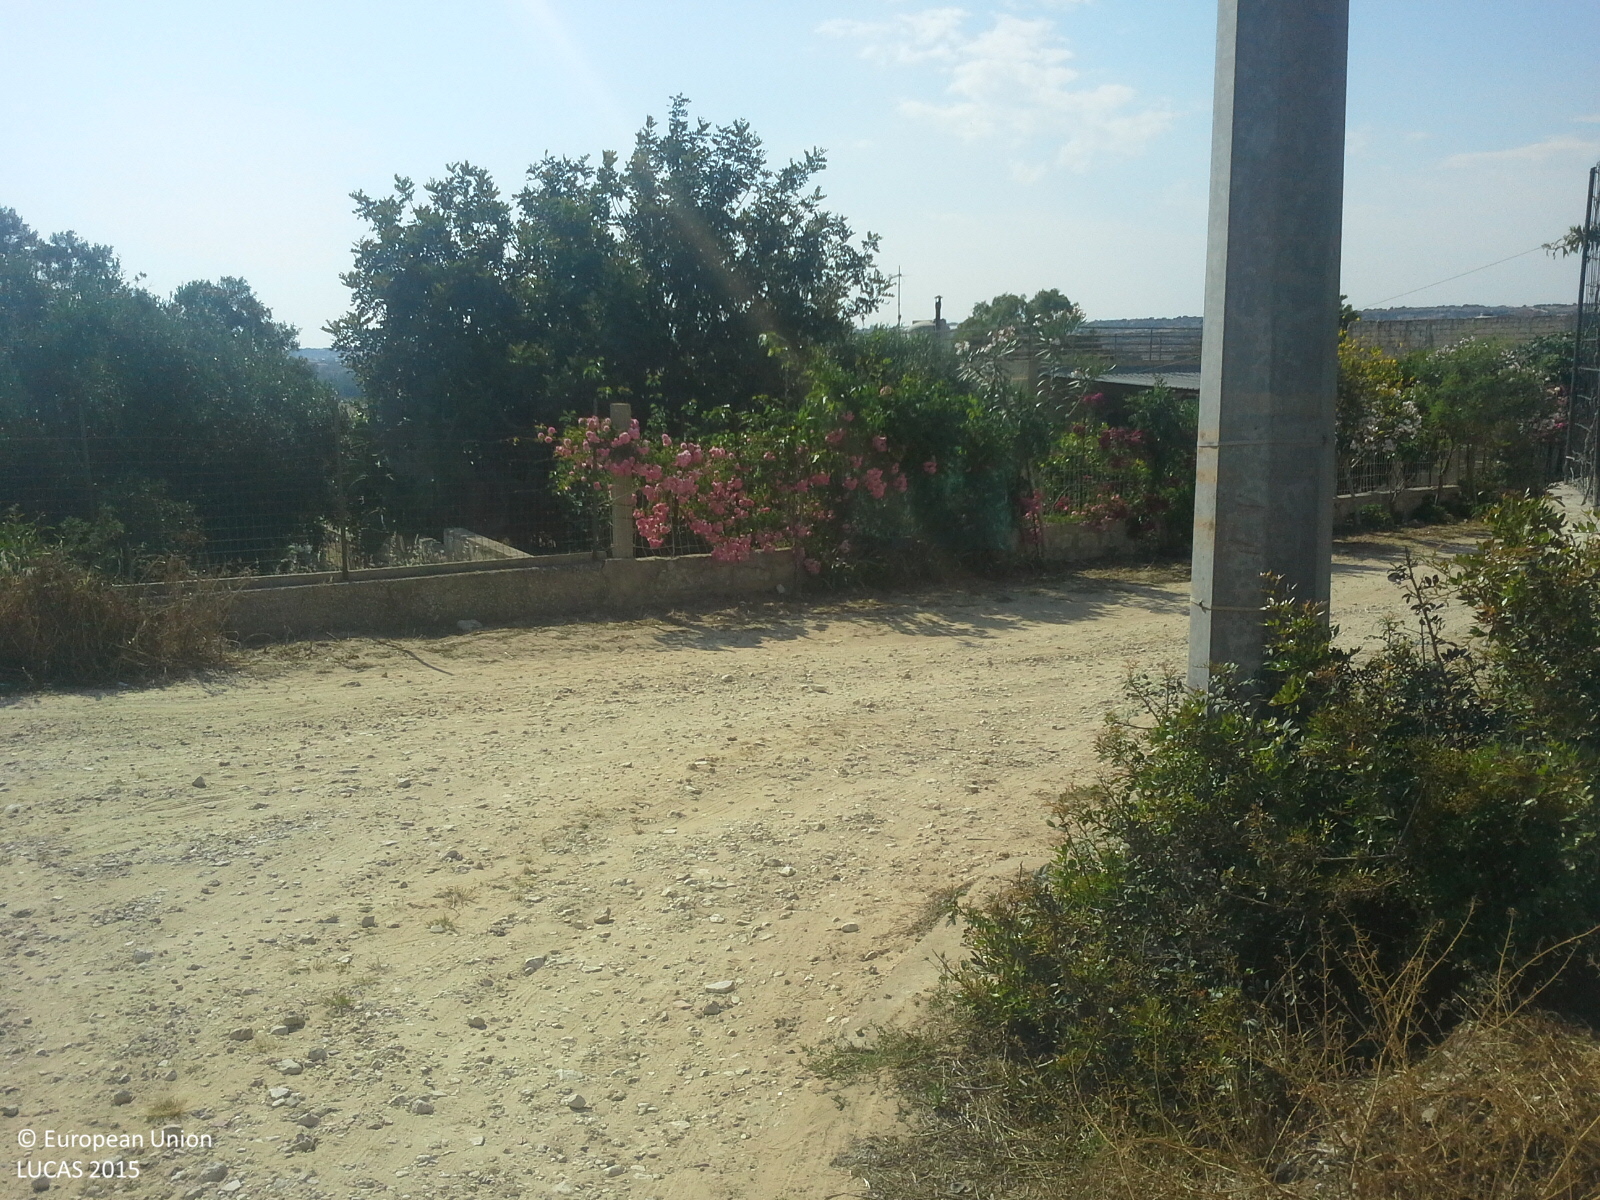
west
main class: Cropland
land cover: Olive groves
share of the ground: > 75 %
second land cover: Spontaneously vegetated surfaces
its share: > 75 %
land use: Agriculture (excluding fallow land and kitchen gardens)
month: June
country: IT
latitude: 36.7186
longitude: 14.7641
